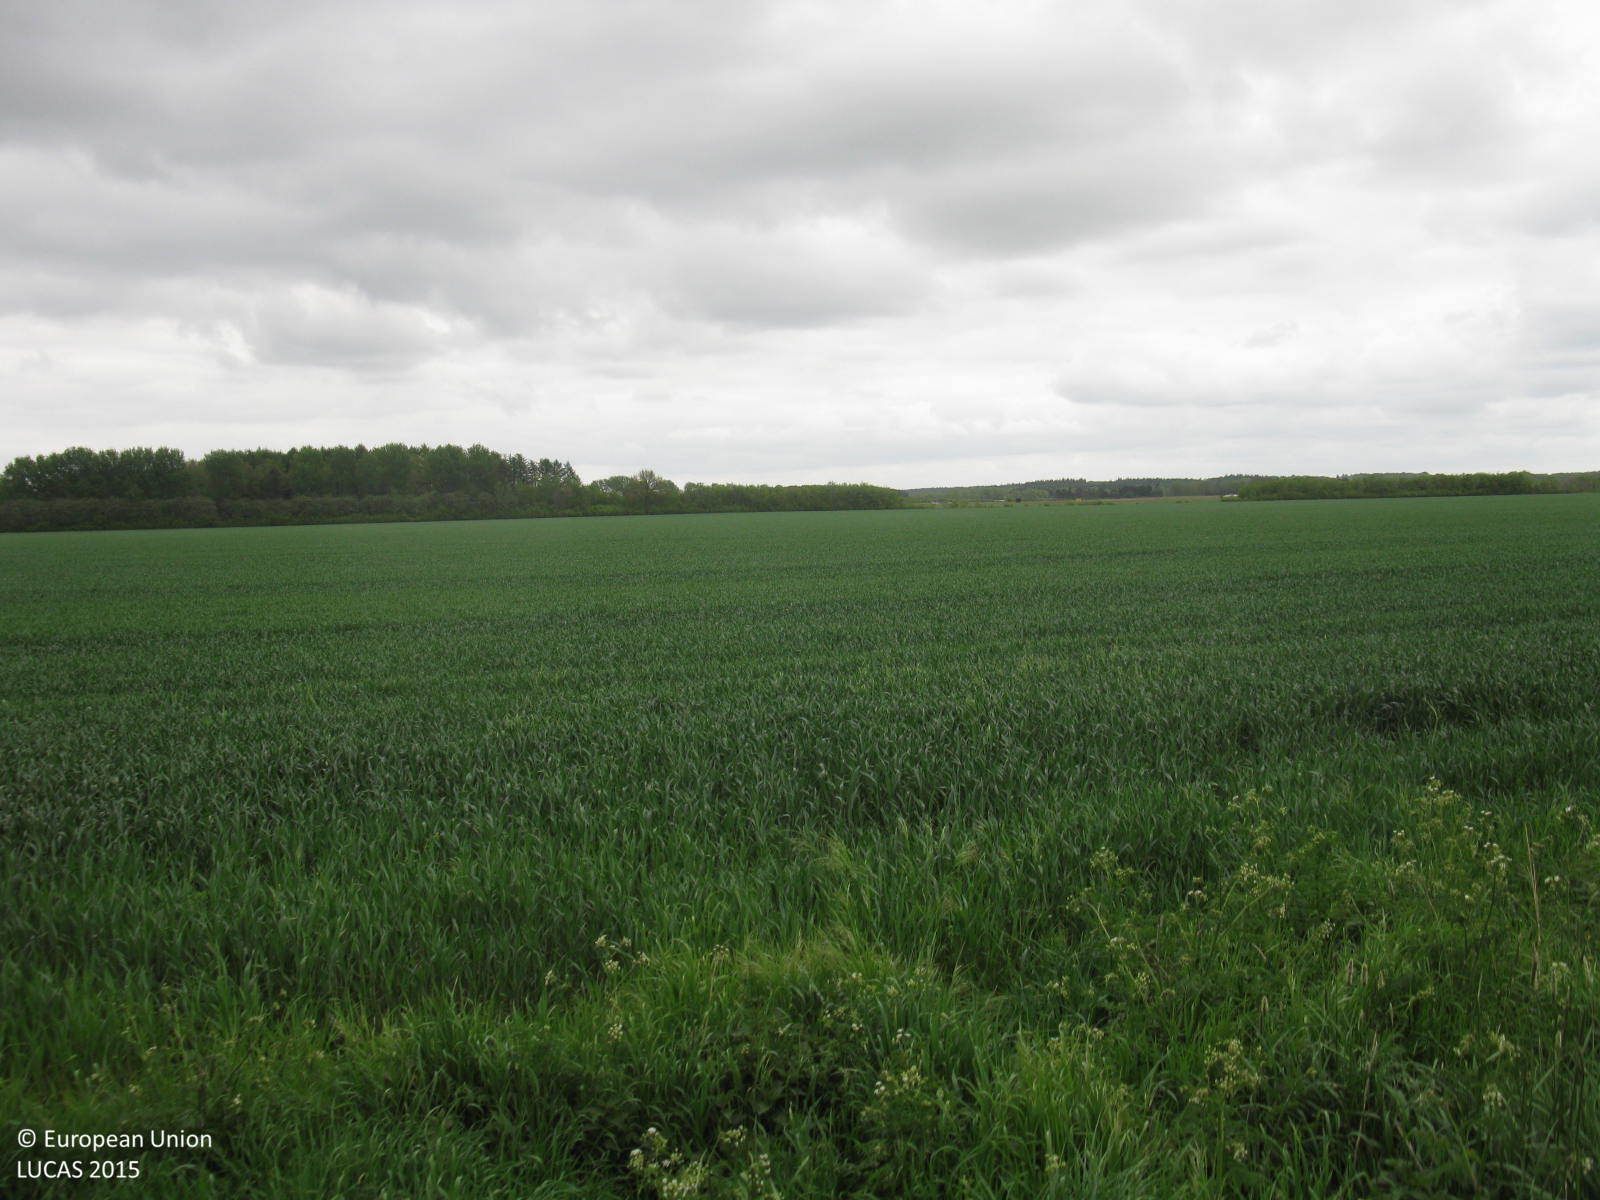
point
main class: Cropland
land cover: Triticale
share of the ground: > 75 %
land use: Agriculture (excluding fallow land and kitchen gardens)
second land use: Community services
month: May
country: DE
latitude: 52.8706
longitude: 7.4006
